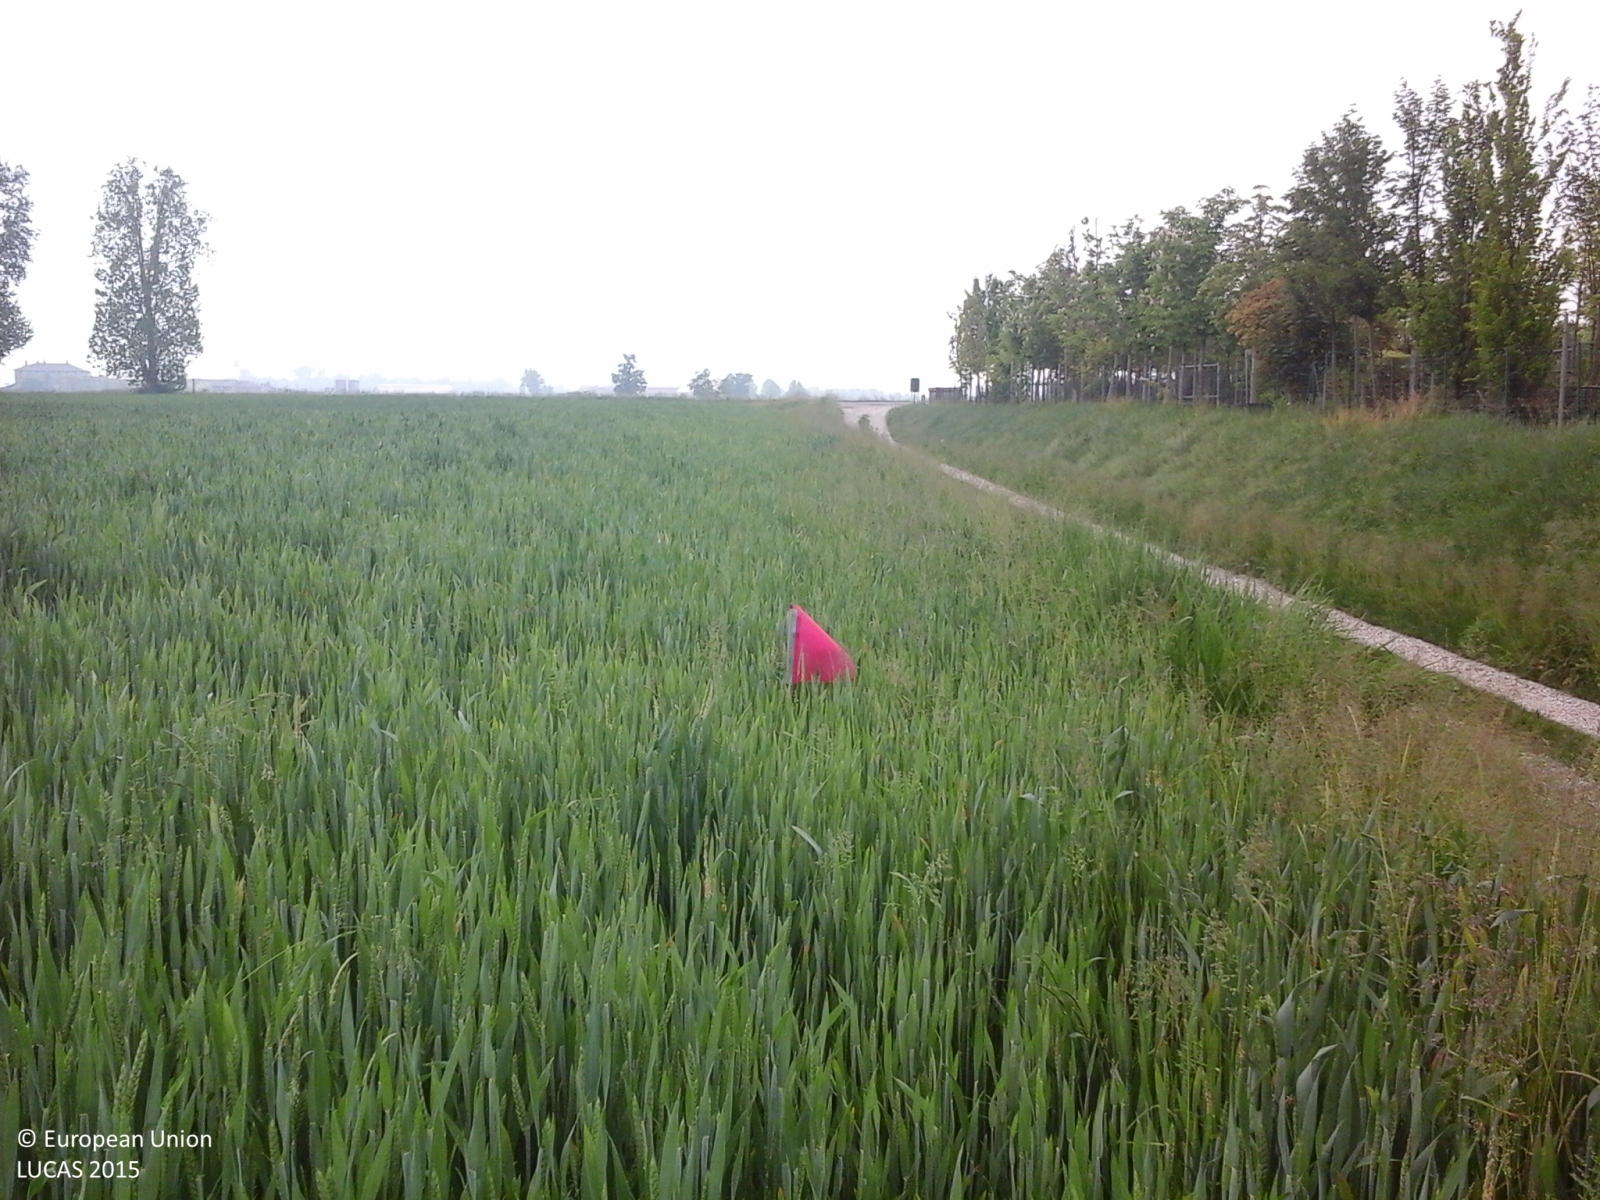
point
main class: Cropland
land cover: Common wheat
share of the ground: > 75 %
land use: Agriculture (excluding fallow land and kitchen gardens)
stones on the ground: < 10 %
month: May
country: IT
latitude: 45.1615
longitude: 10.2920
